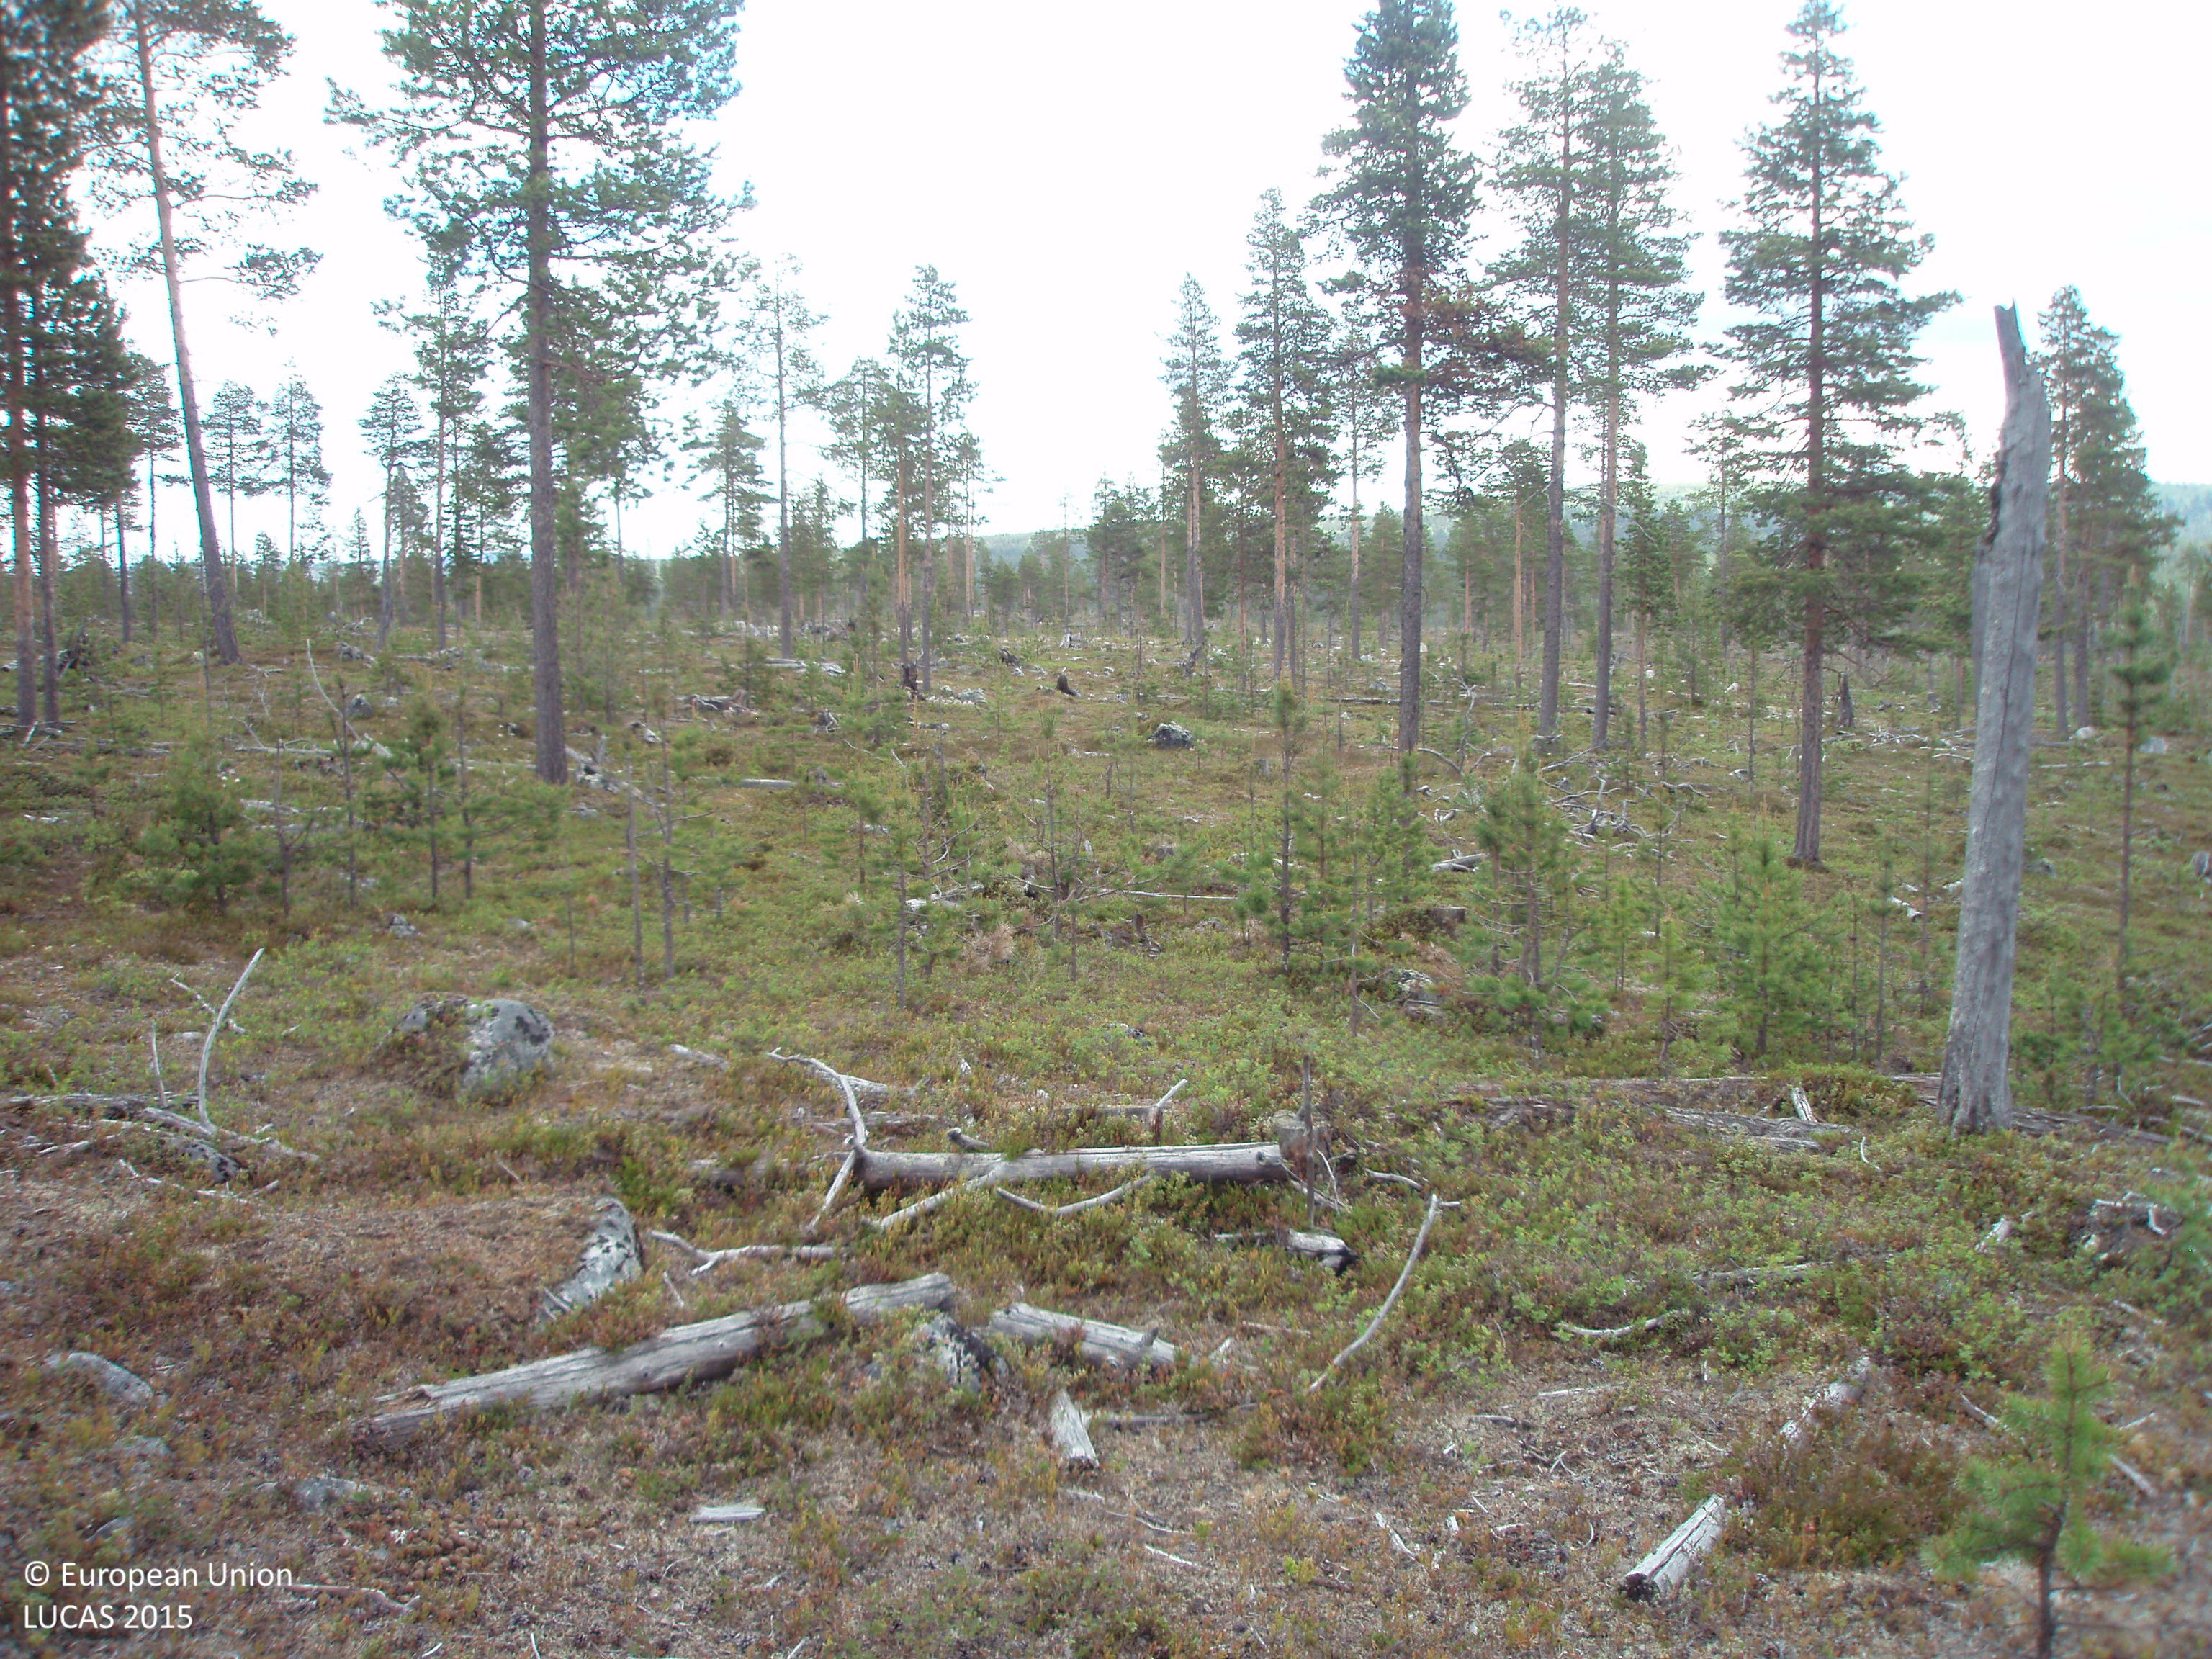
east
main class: Woodland
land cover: Pine dominated coniferous woodland
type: boreal forest
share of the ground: 10 - 25 %
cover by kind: shrubs 65 %, coniferous forest trees 15 %, lichens and mosses 15 %, unconsolidated bare surface 5 %
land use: Forestry
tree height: > 5 m
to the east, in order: Pine dominated coniferous woodland; Tracks; Pine dominated coniferous woodland
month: July
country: FI
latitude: 68.8783
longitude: 25.9249
